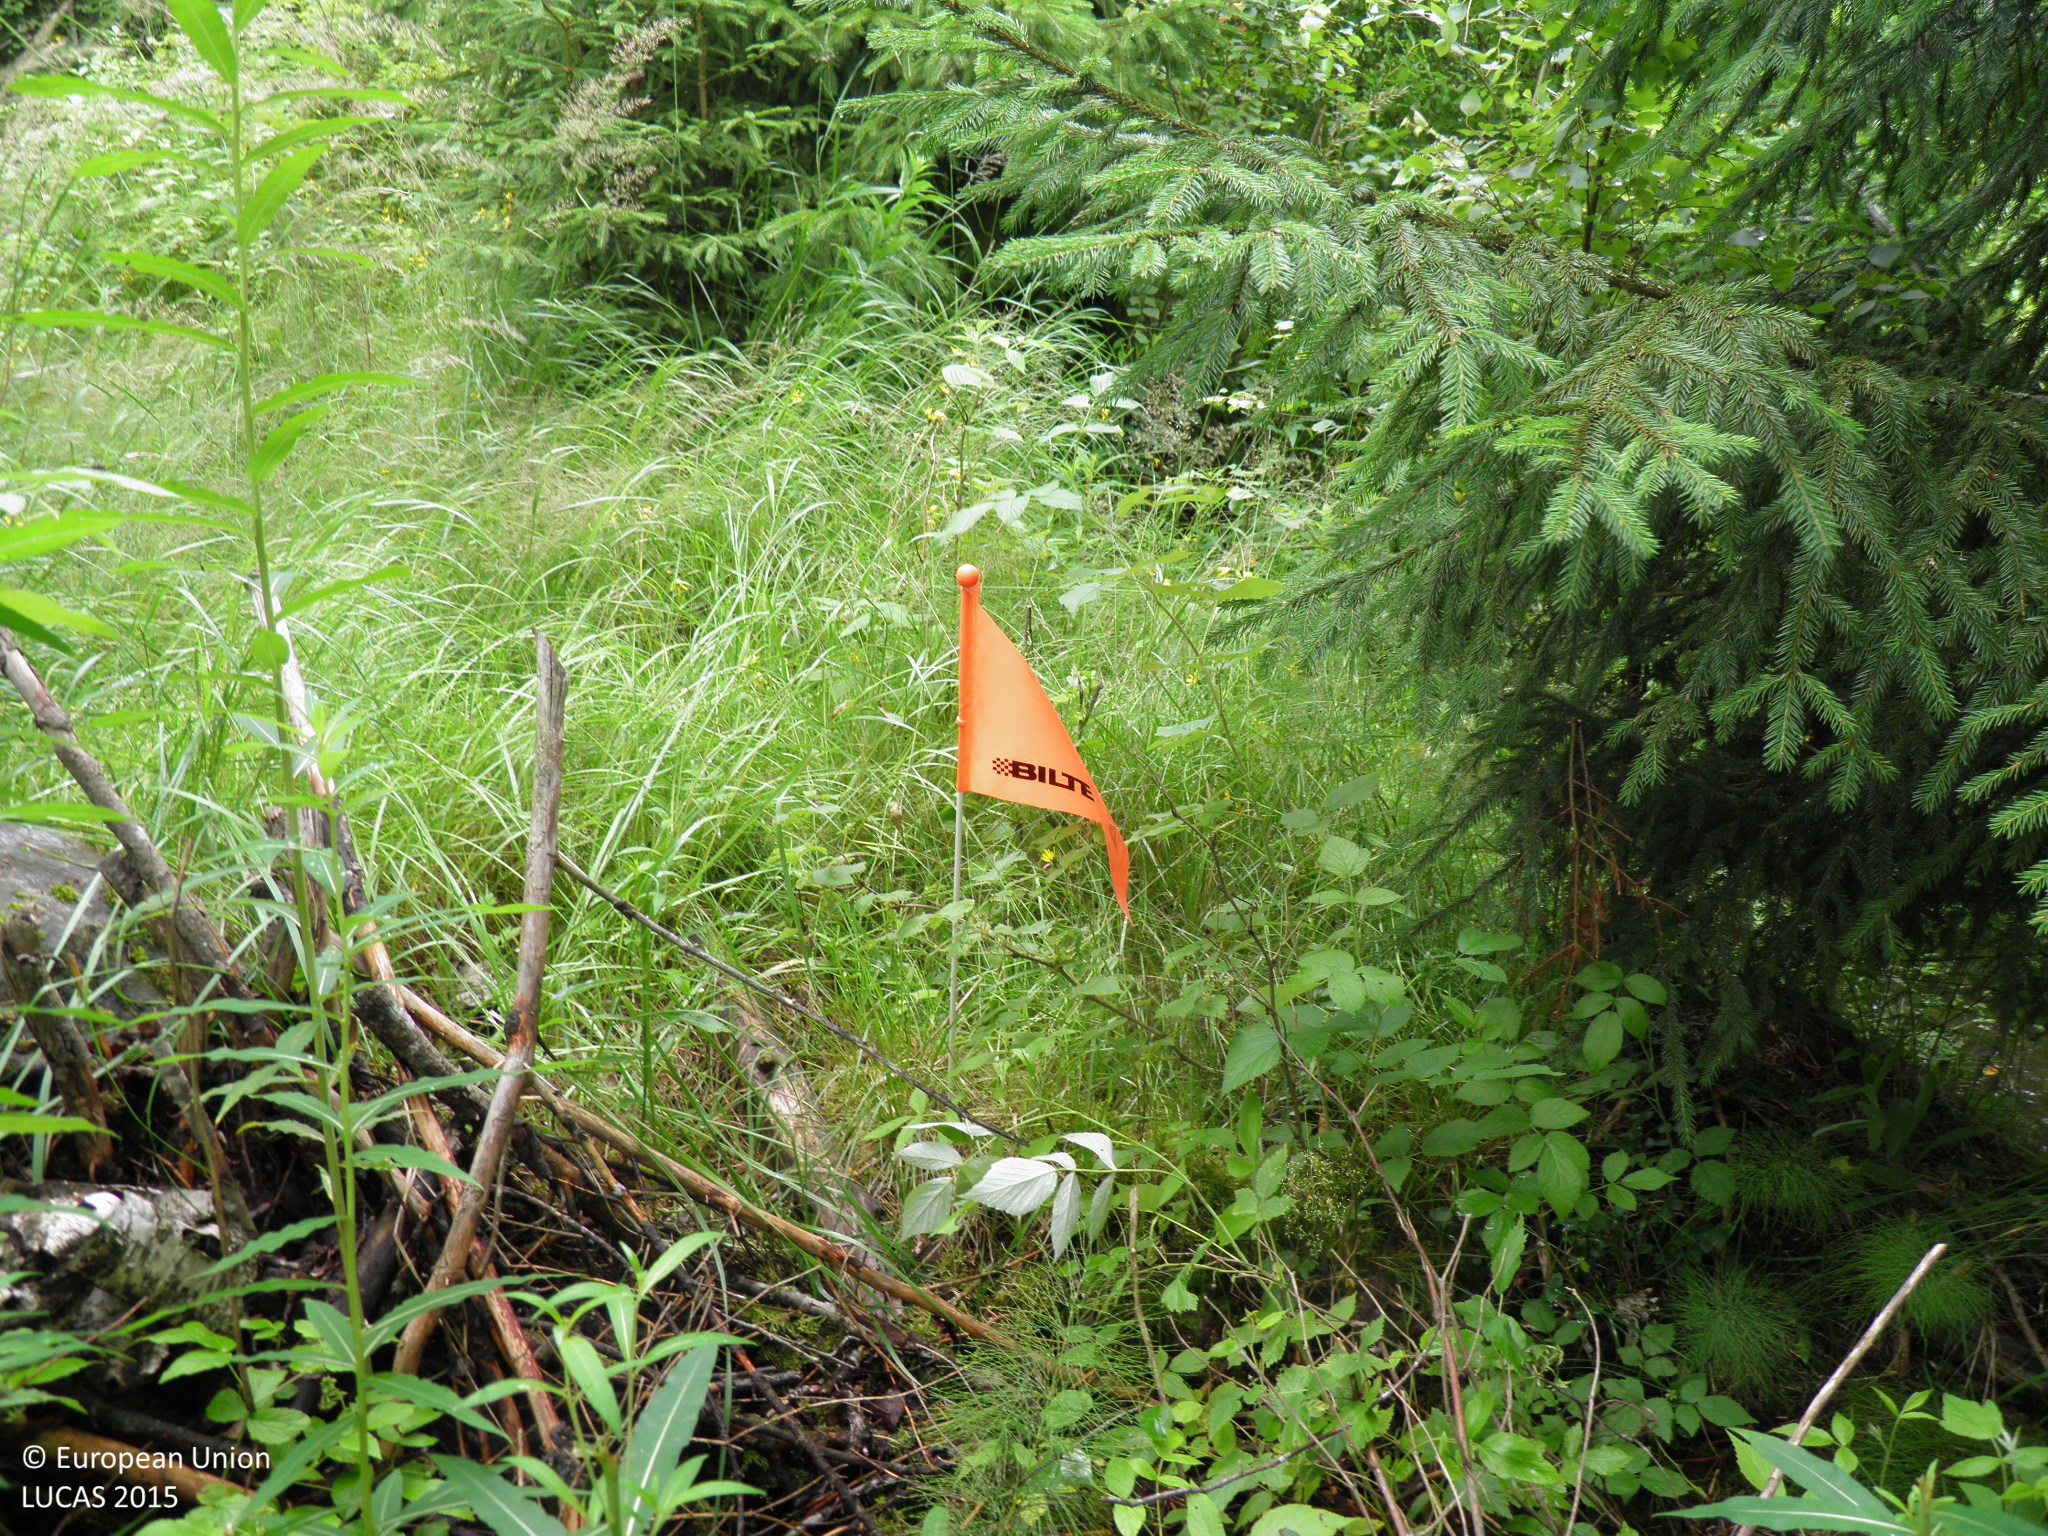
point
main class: Woodland
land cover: Spruce dominated mixed woodland
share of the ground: 50 - 75 %
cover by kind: broadleaved forest trees 40 %, coniferous forest trees 25 %, shrubs 20 %, herbaceous plants 15 %
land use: Forestry
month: July
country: FI
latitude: 60.8917
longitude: 22.8062
